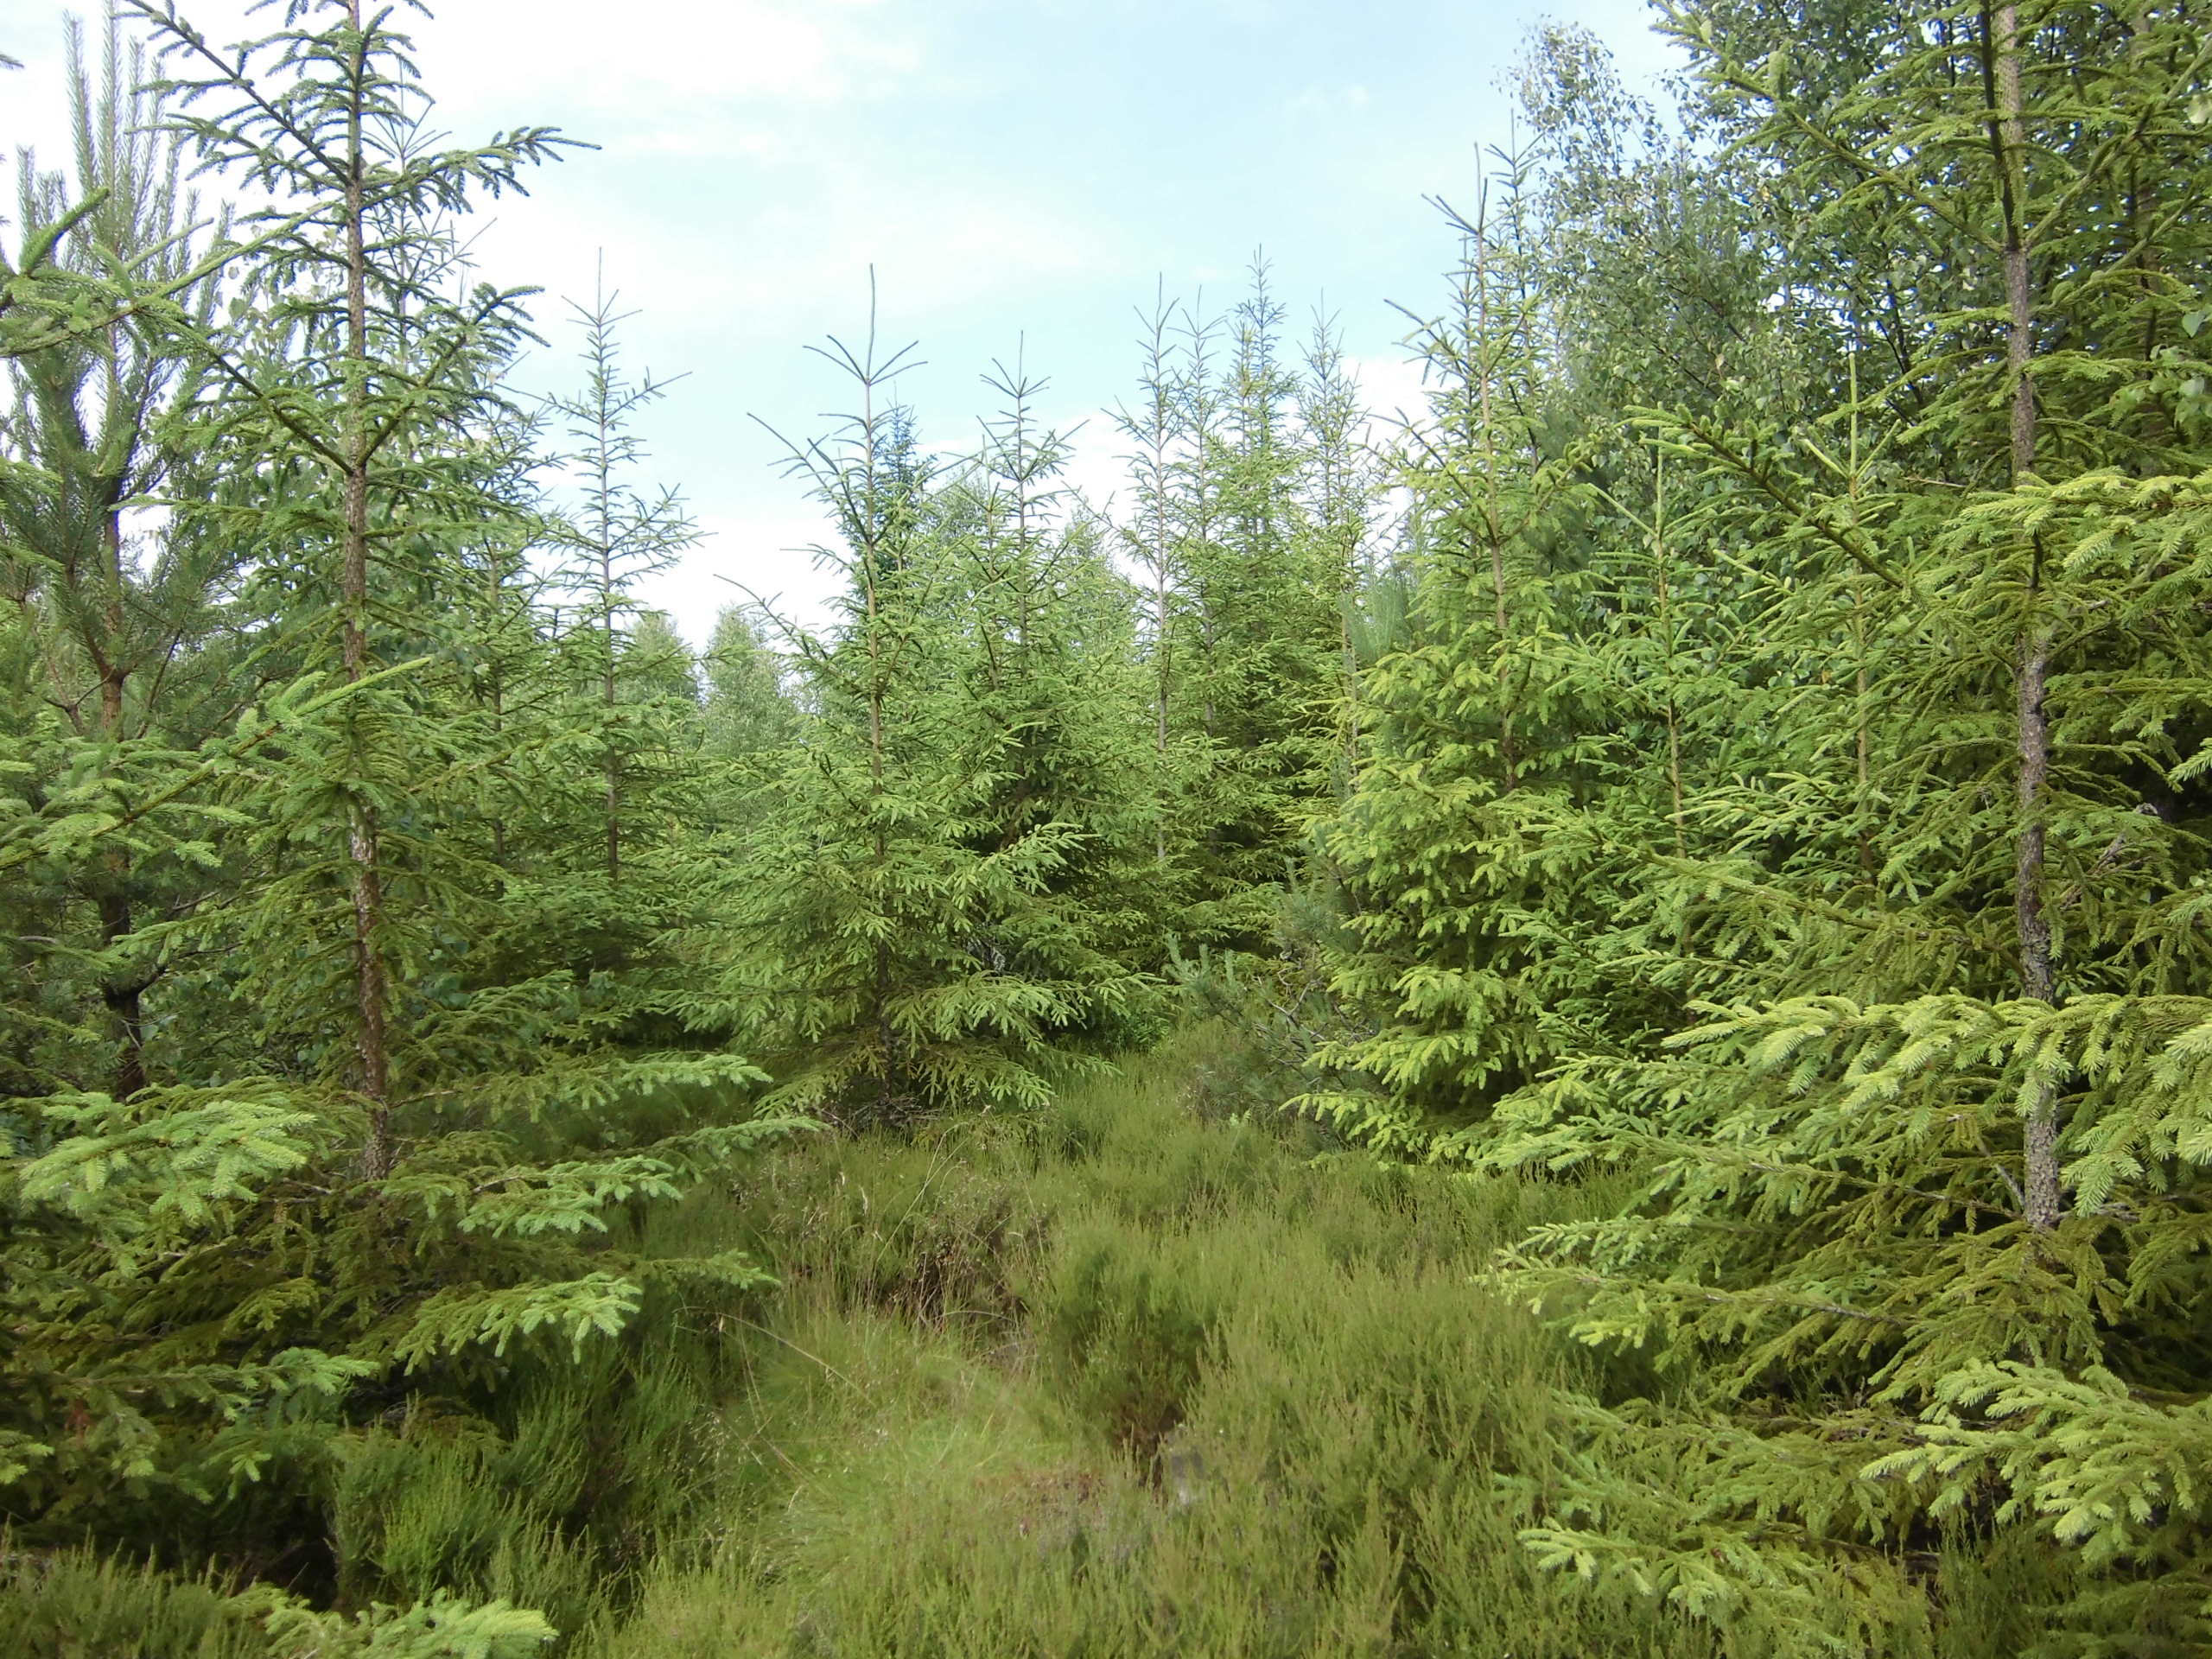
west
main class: Woodland
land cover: Spruce dominated coniferous woodland
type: boreal forest
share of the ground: 50 - 75 %
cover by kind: coniferous forest trees 50 %, shrubs 25 %, broadleaved forest trees 10 %, herbaceous plants 10 %, lichens and mosses 5 %
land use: Forestry
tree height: > 5 m
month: July
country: SE
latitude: 57.1017
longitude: 15.3956
